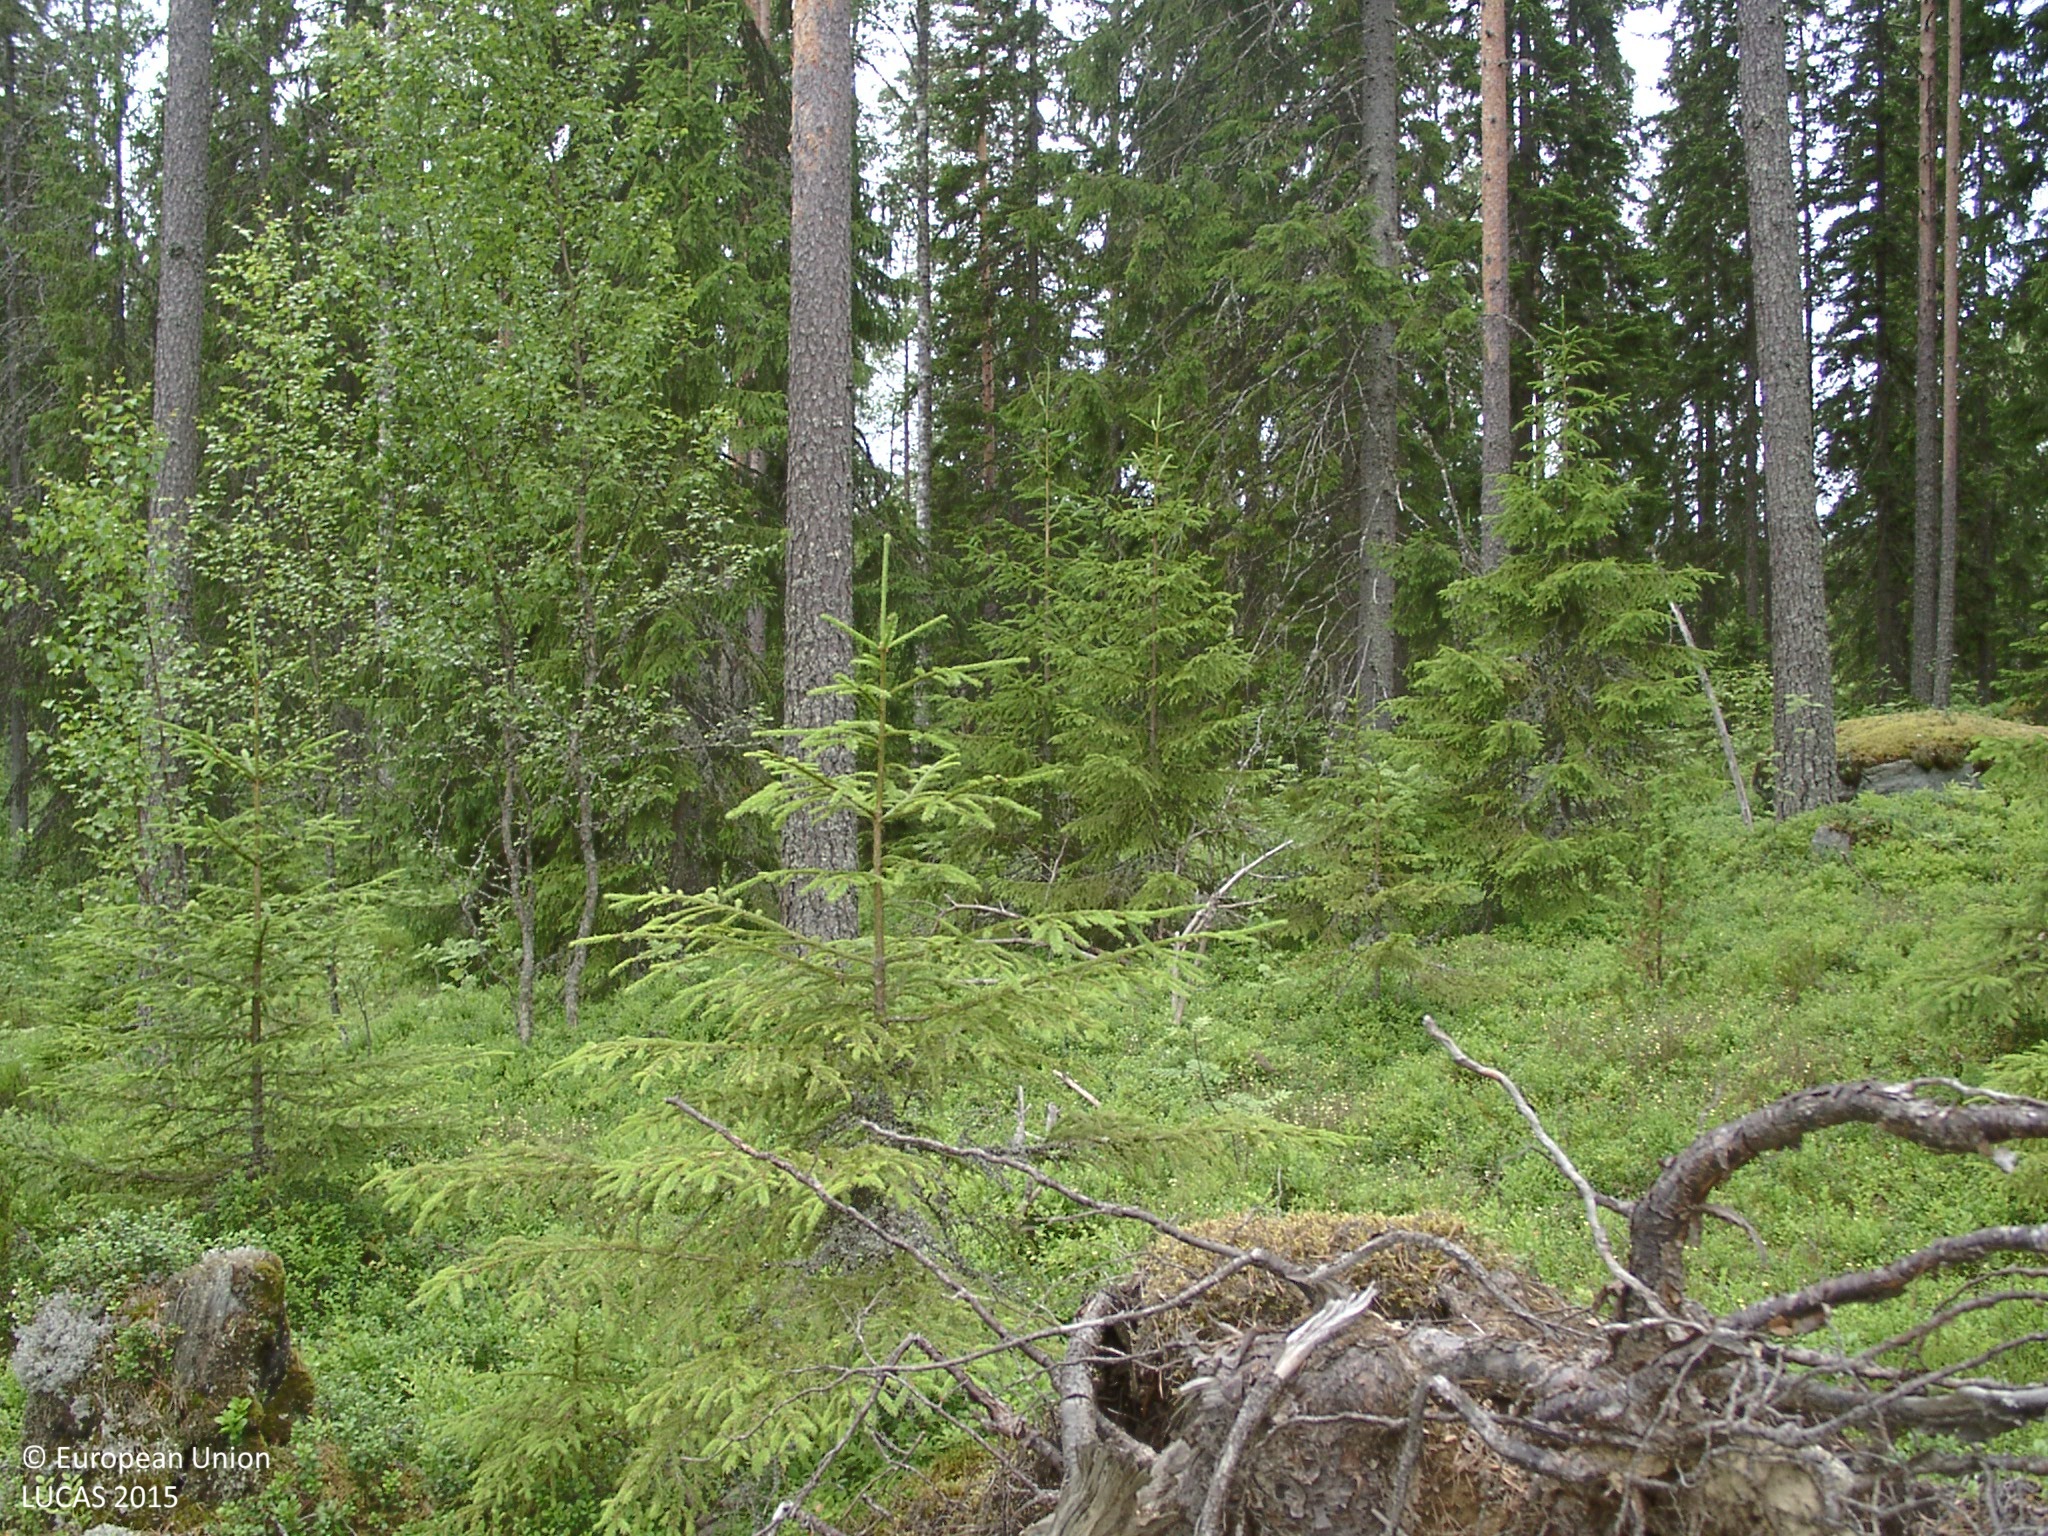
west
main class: Woodland
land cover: Other mixed woodland
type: boreal forest
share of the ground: 50 - 75 %
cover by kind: shrubs 40 %, coniferous forest trees 35 %, broadleaved forest trees 15 %, lichens and mosses 10 %
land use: Forestry
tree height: > 5 m
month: July
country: FI
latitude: 61.7027
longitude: 25.2217
